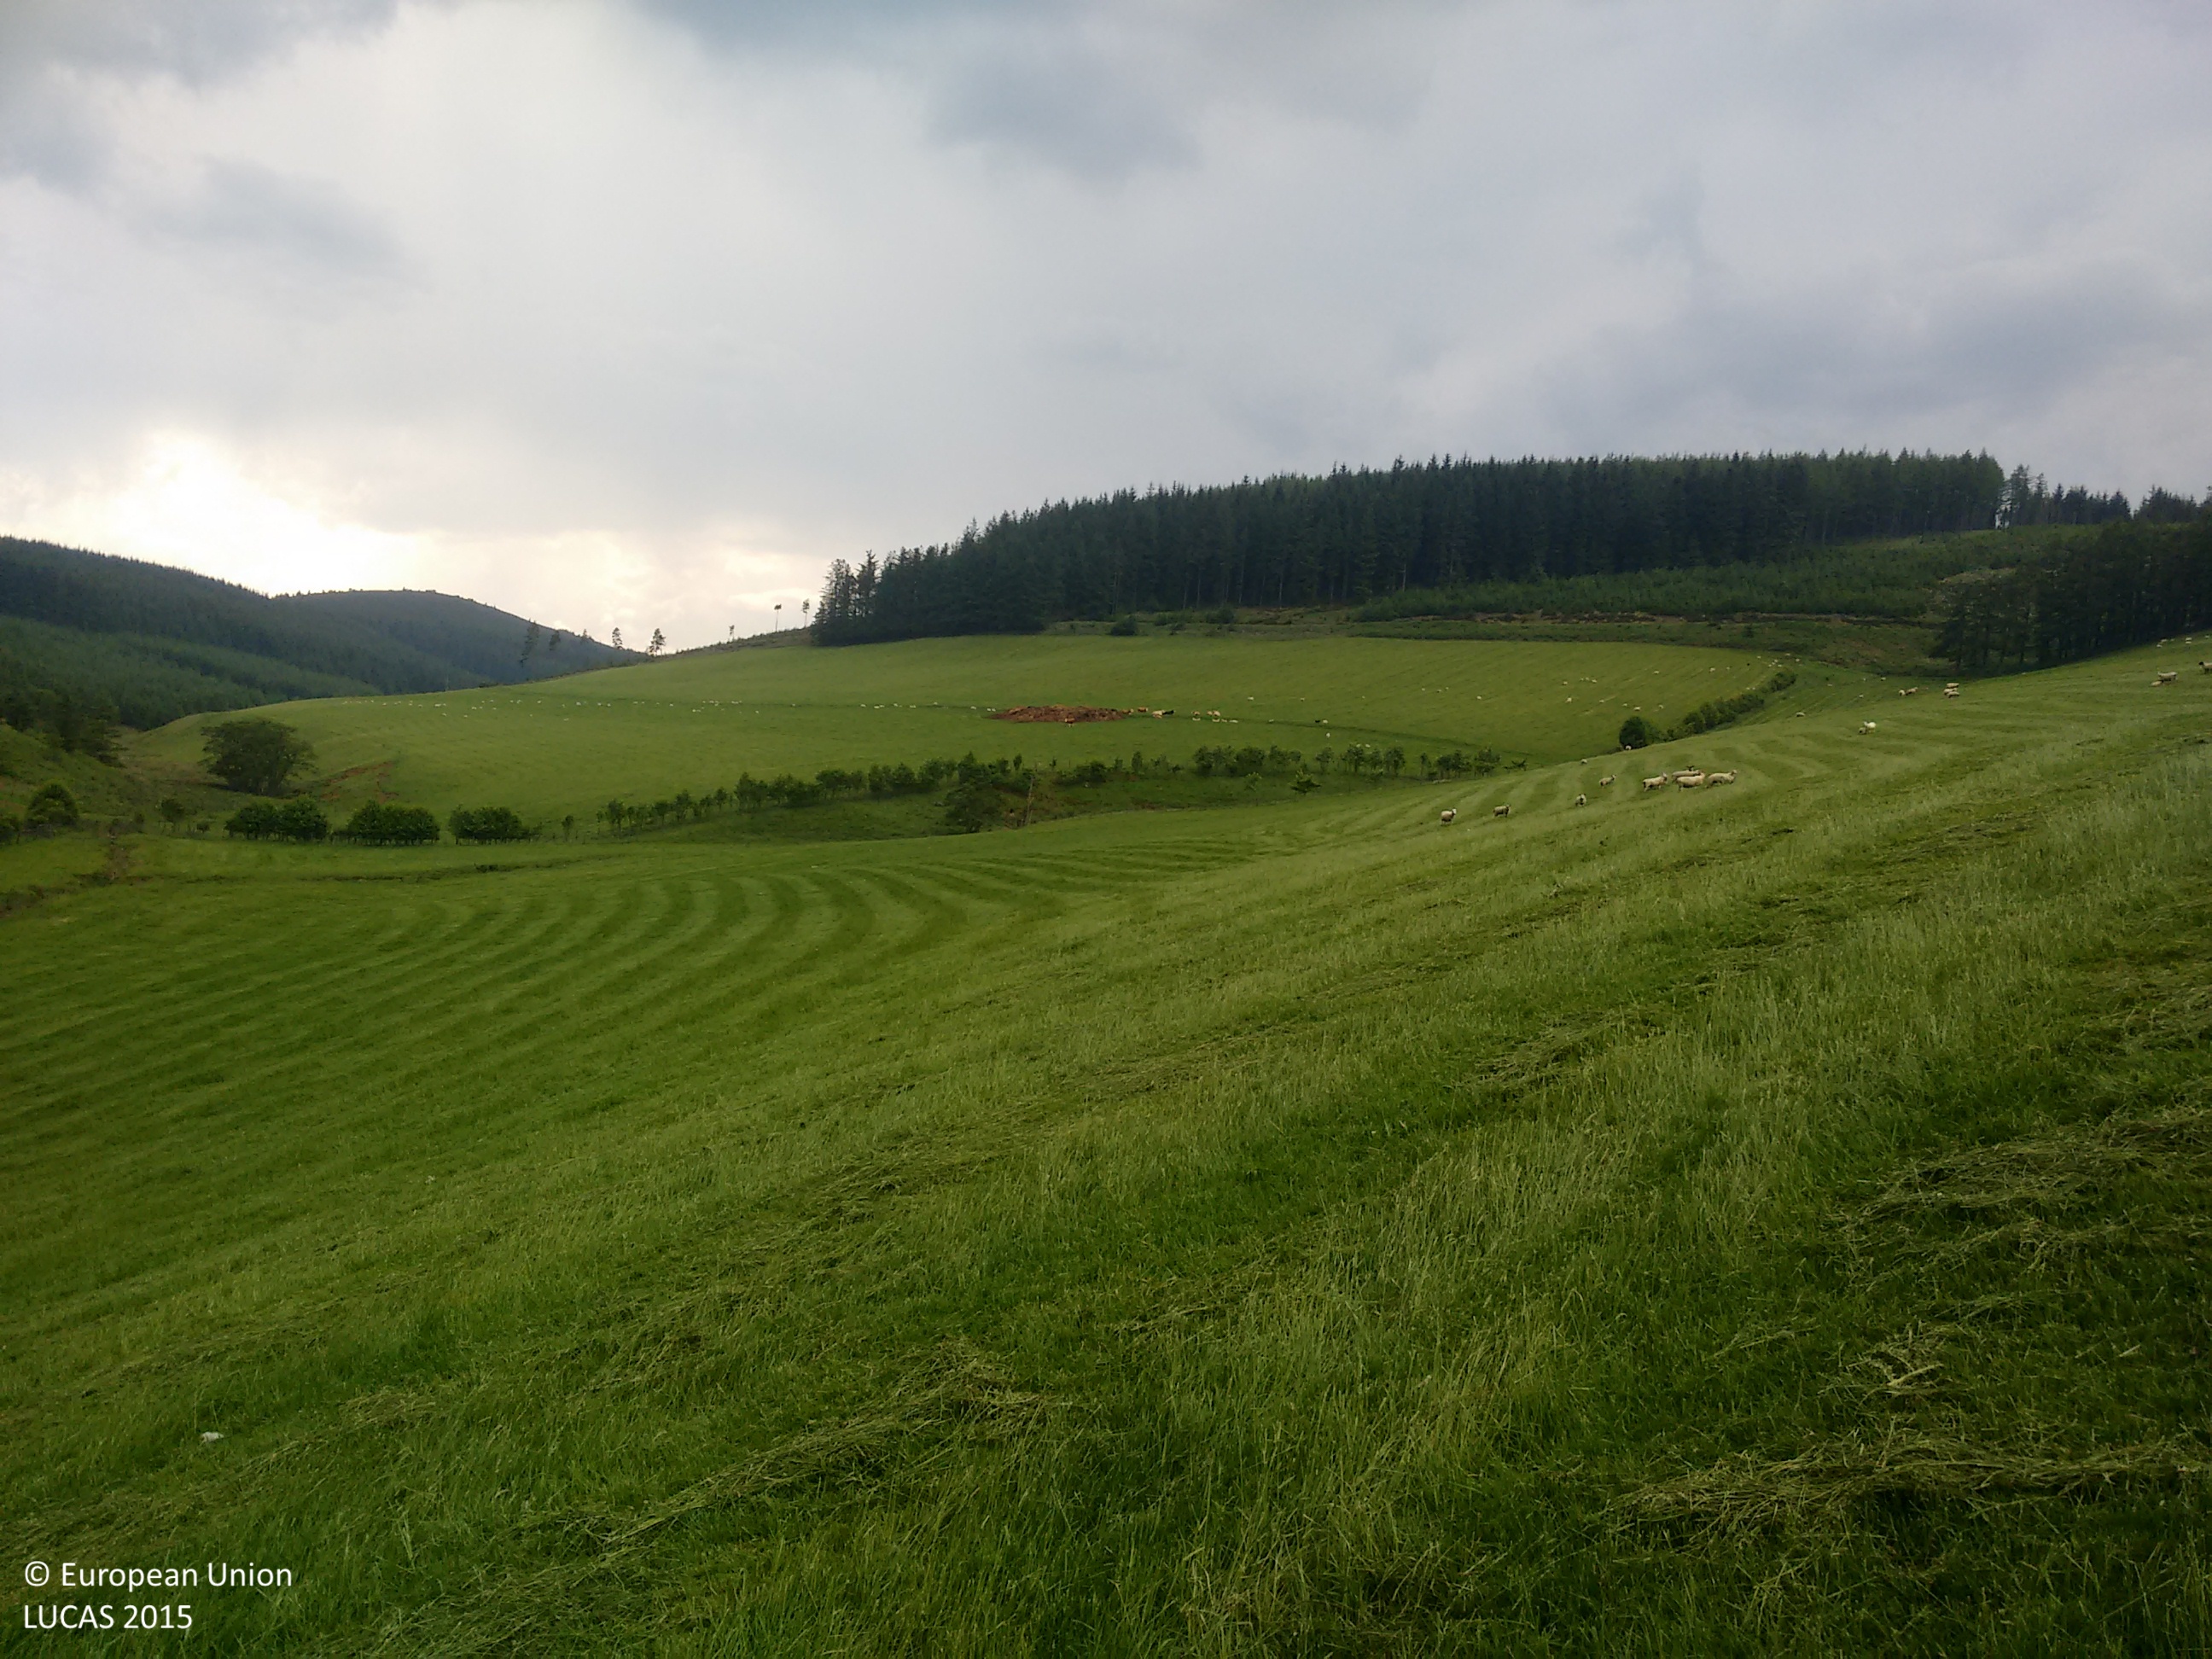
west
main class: Grassland
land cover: Grassland without tree/shrub cover
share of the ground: > 75 %
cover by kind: herbaceous plants 100 %
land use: Agriculture (excluding fallow land and kitchen gardens)
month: July
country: GB
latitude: 57.3804
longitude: -2.8498
